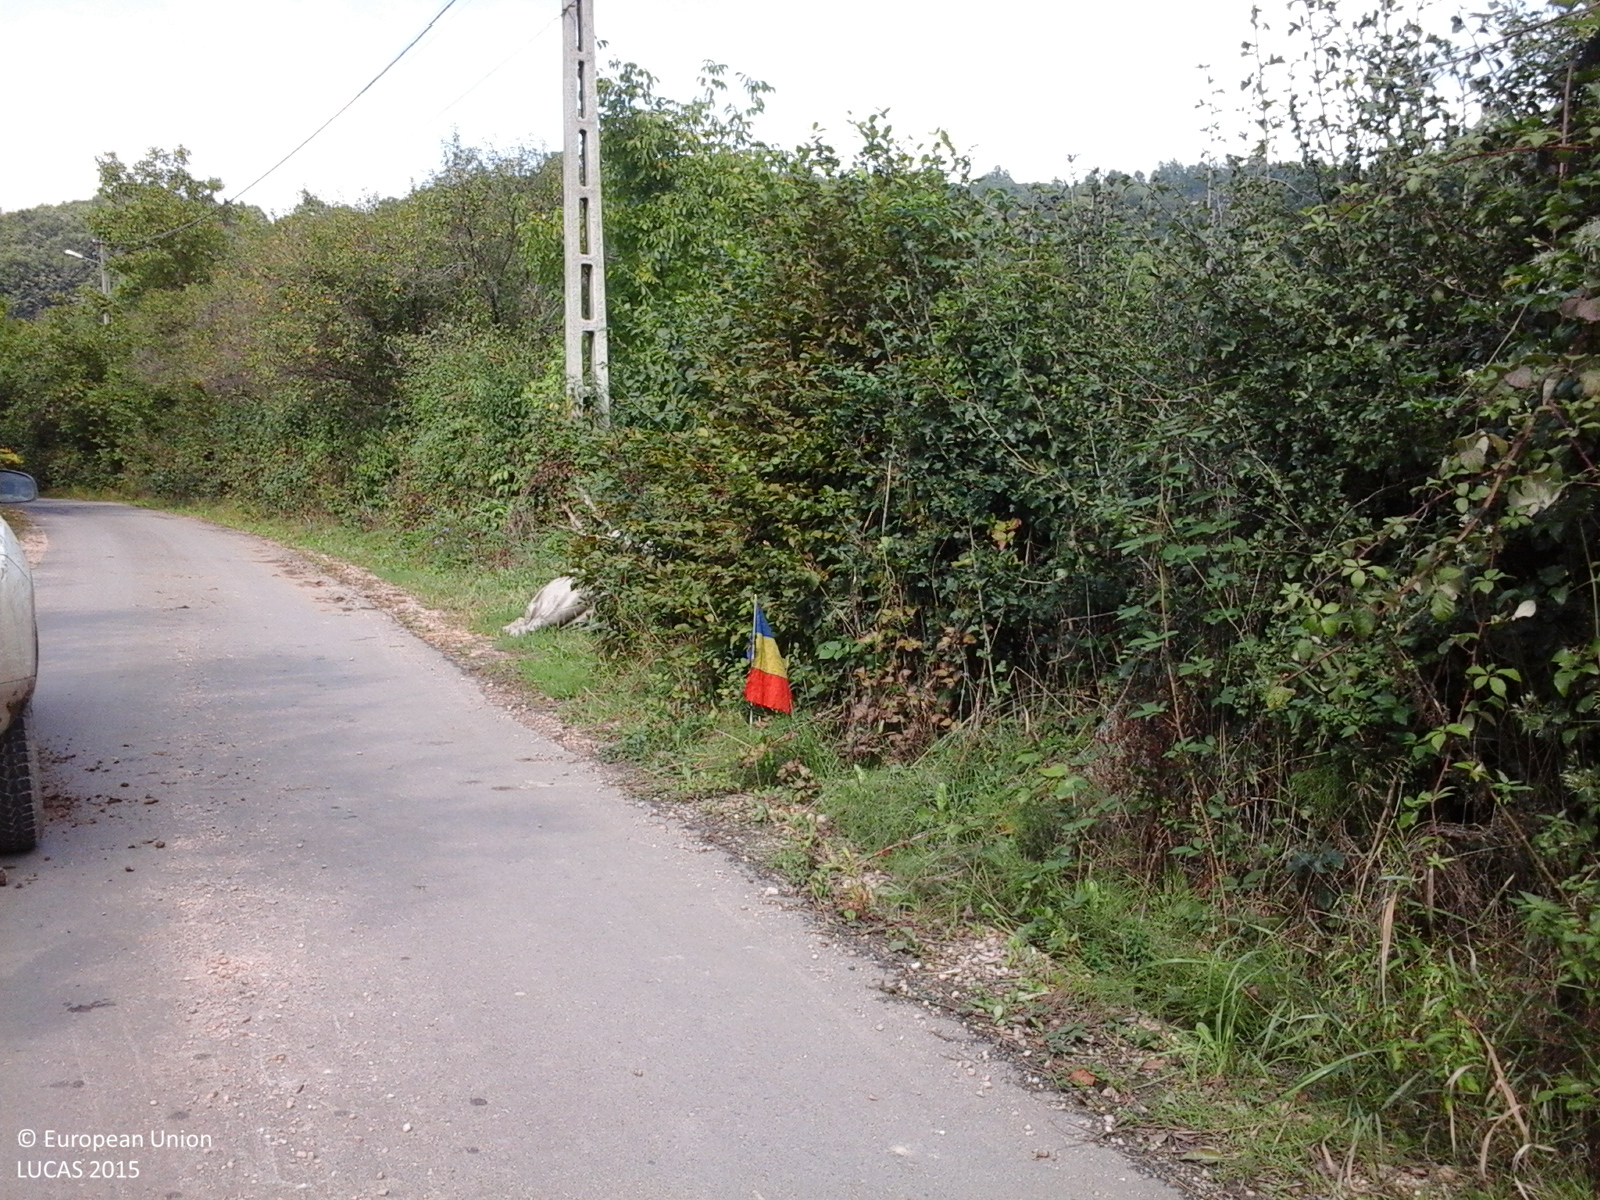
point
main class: Cropland
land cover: Maize
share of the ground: > 75 %
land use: Agriculture (excluding fallow land and kitchen gardens)
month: September
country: RO
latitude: 46.7767
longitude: 22.3752
